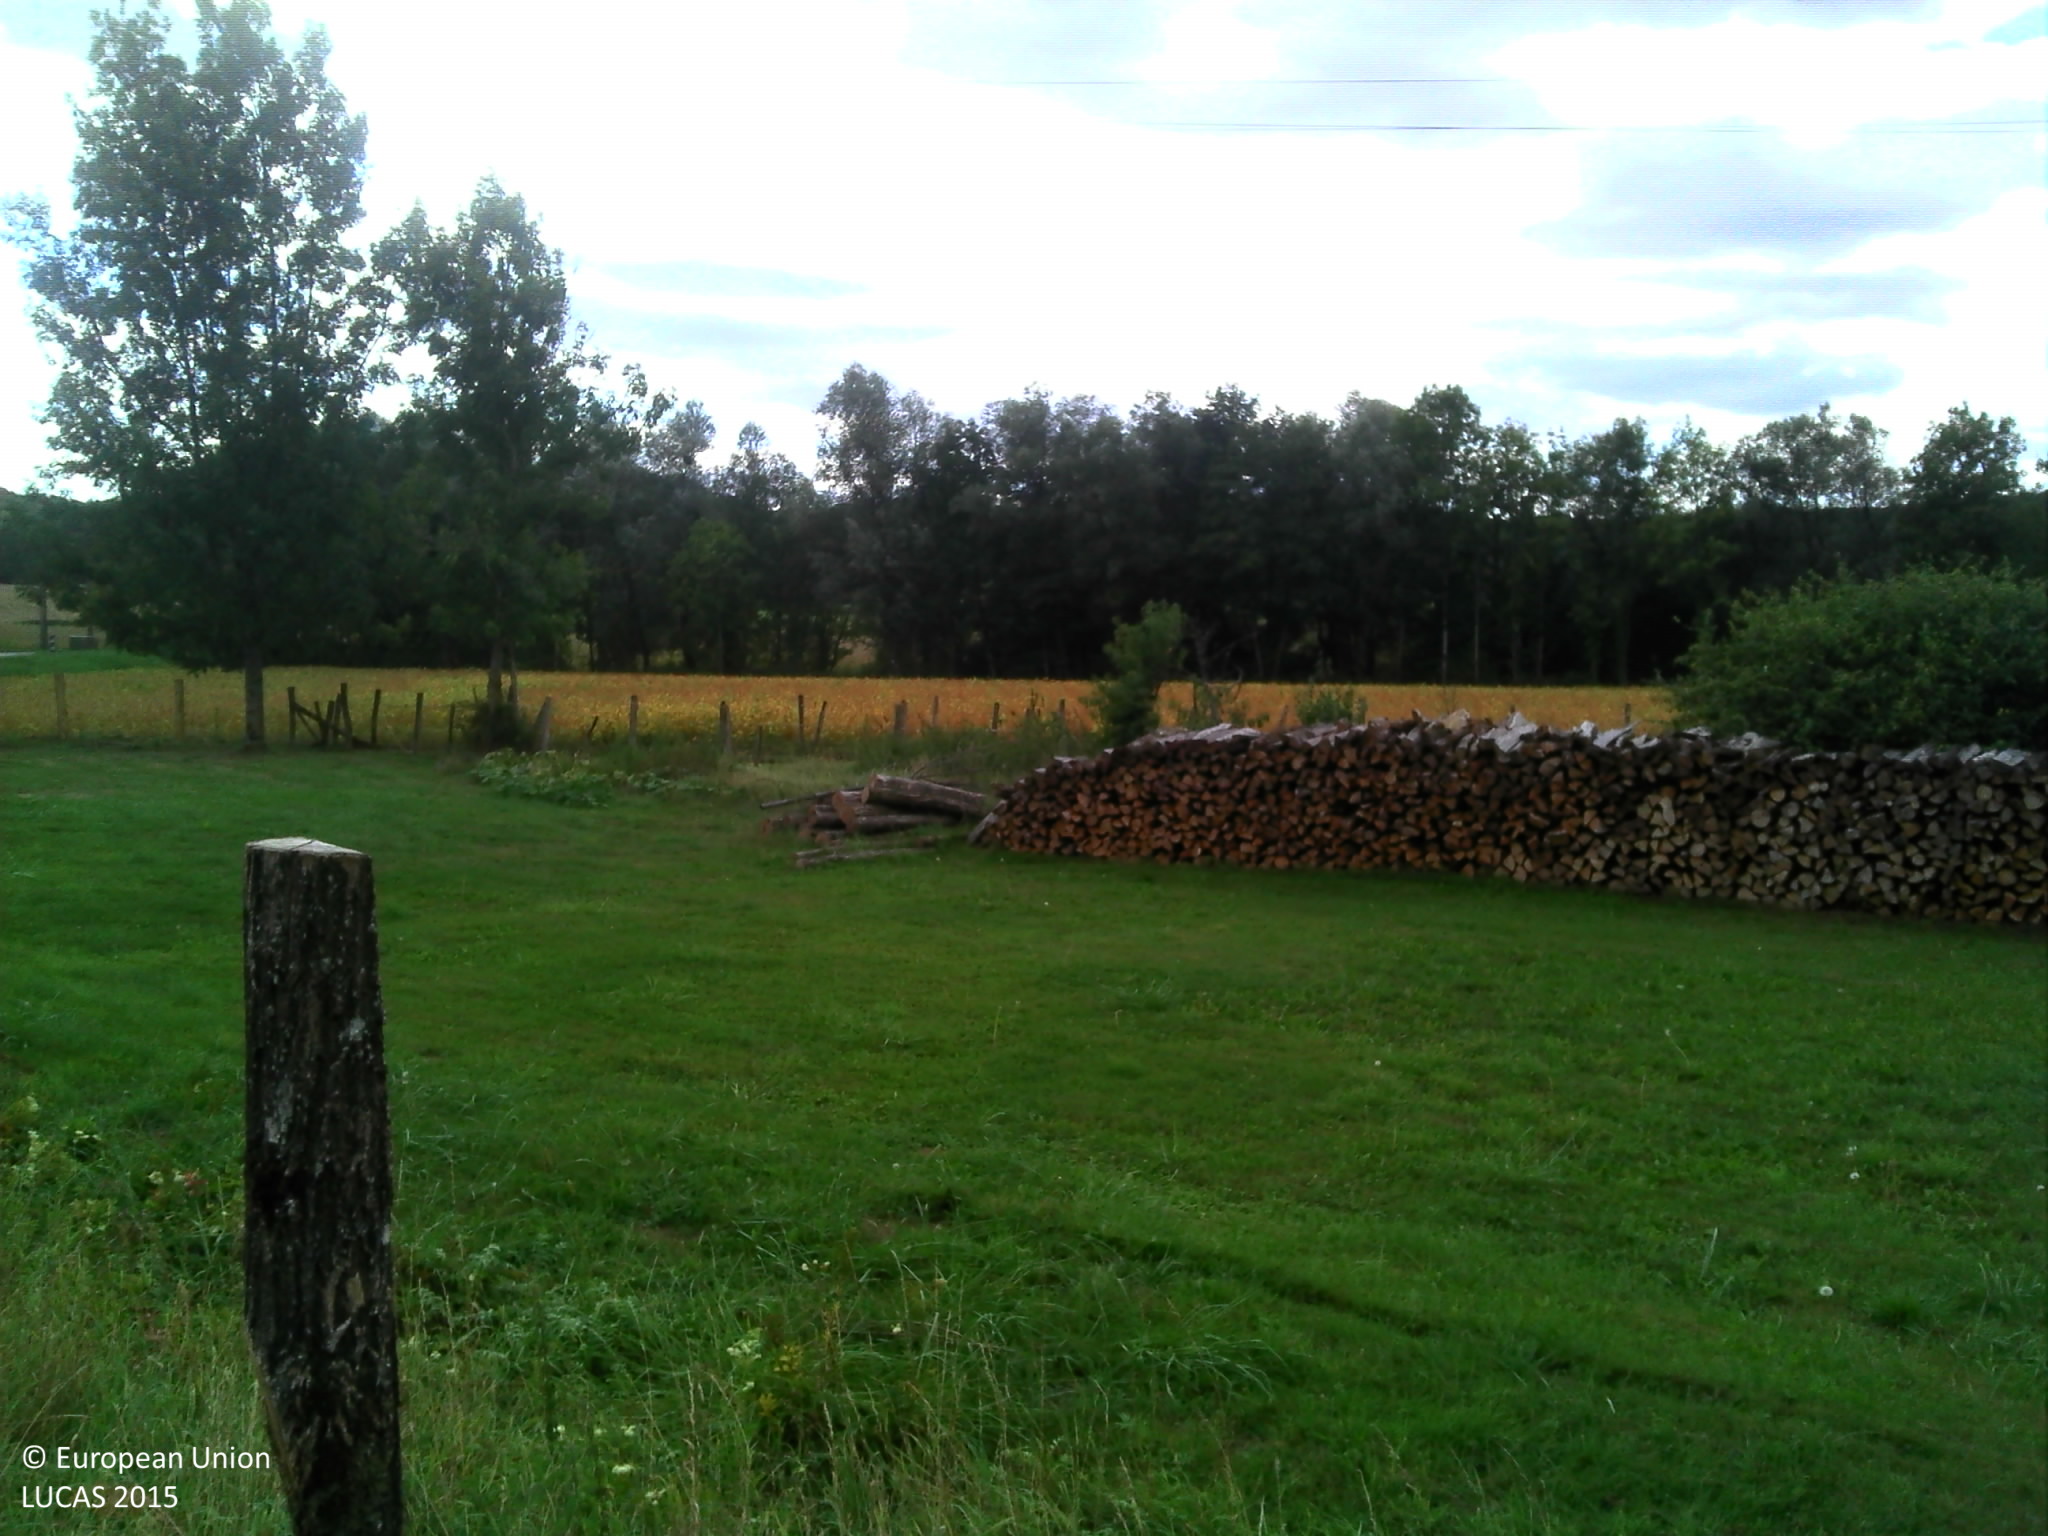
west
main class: Grassland
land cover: Grassland without tree/shrub cover
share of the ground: > 75 %
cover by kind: herbaceous plants 100 %
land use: Residential
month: September
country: FR
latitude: 47.3824
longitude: 6.1736
